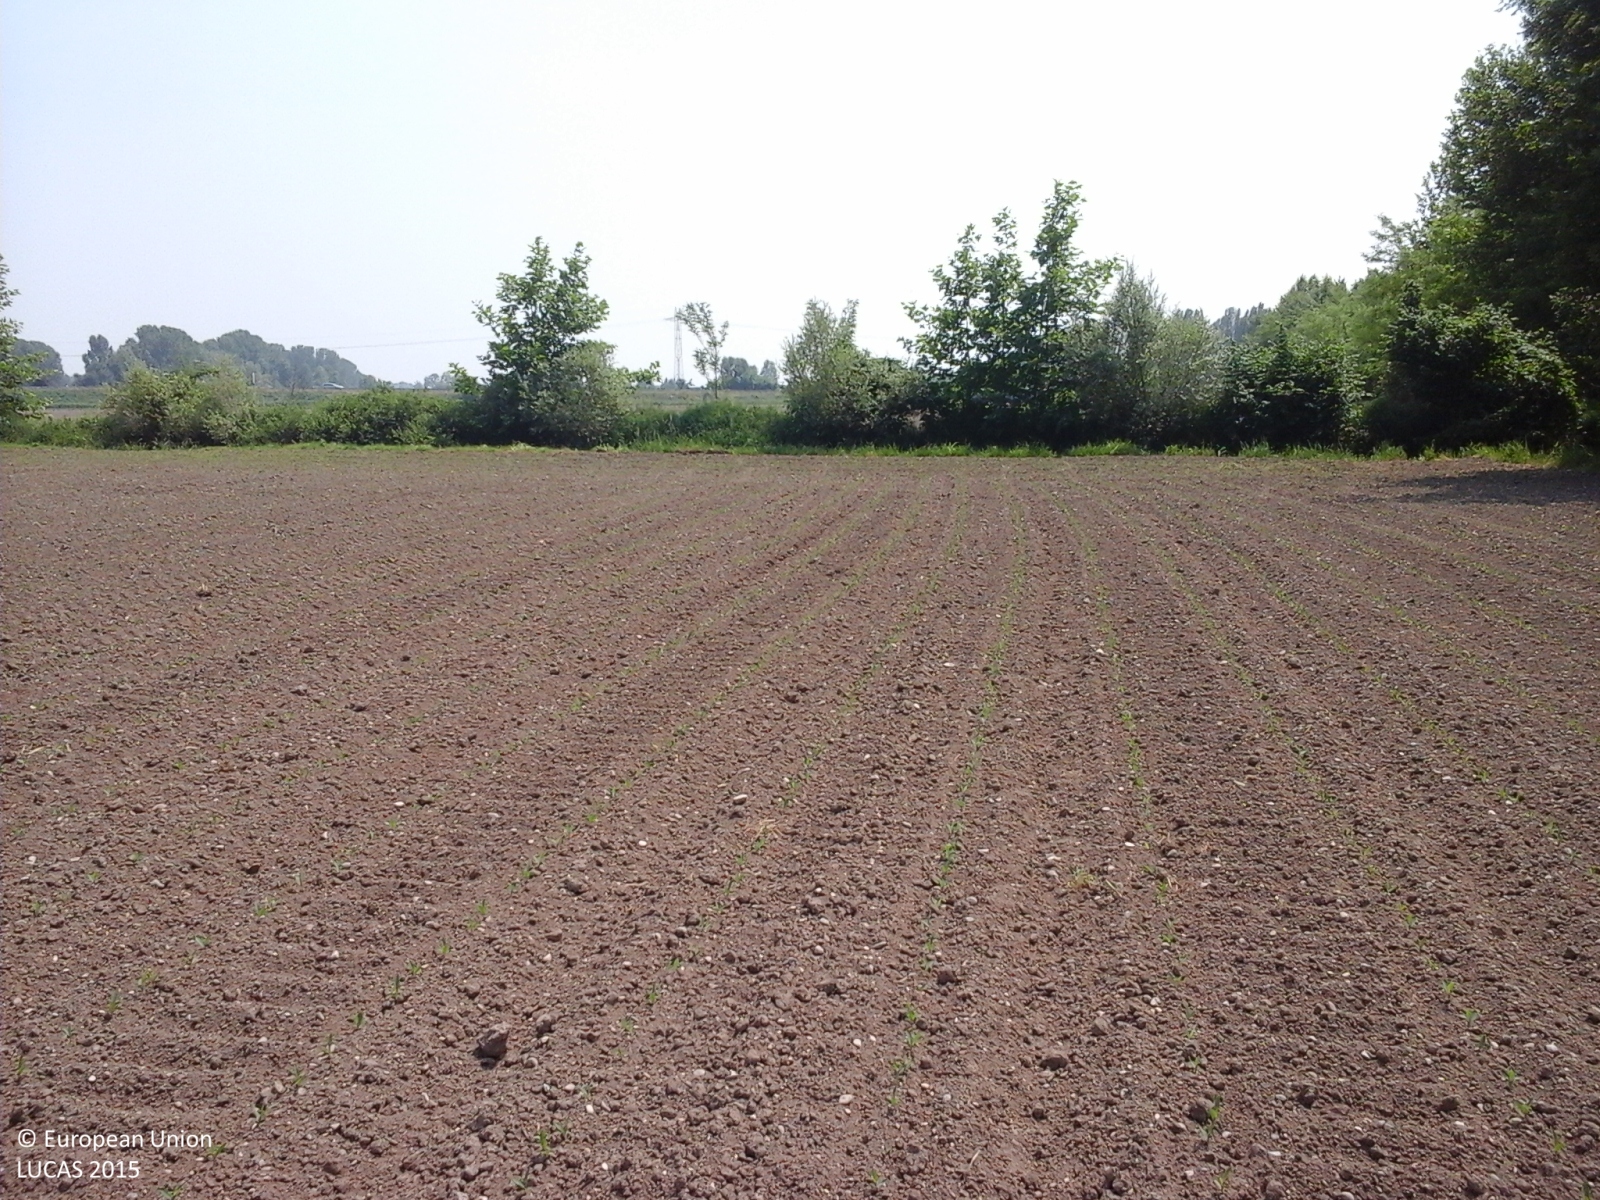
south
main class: Cropland
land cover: Maize
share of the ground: < 10 %
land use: Agriculture (excluding fallow land and kitchen gardens)
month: June
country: IT
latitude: 45.3781
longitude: 10.1912
